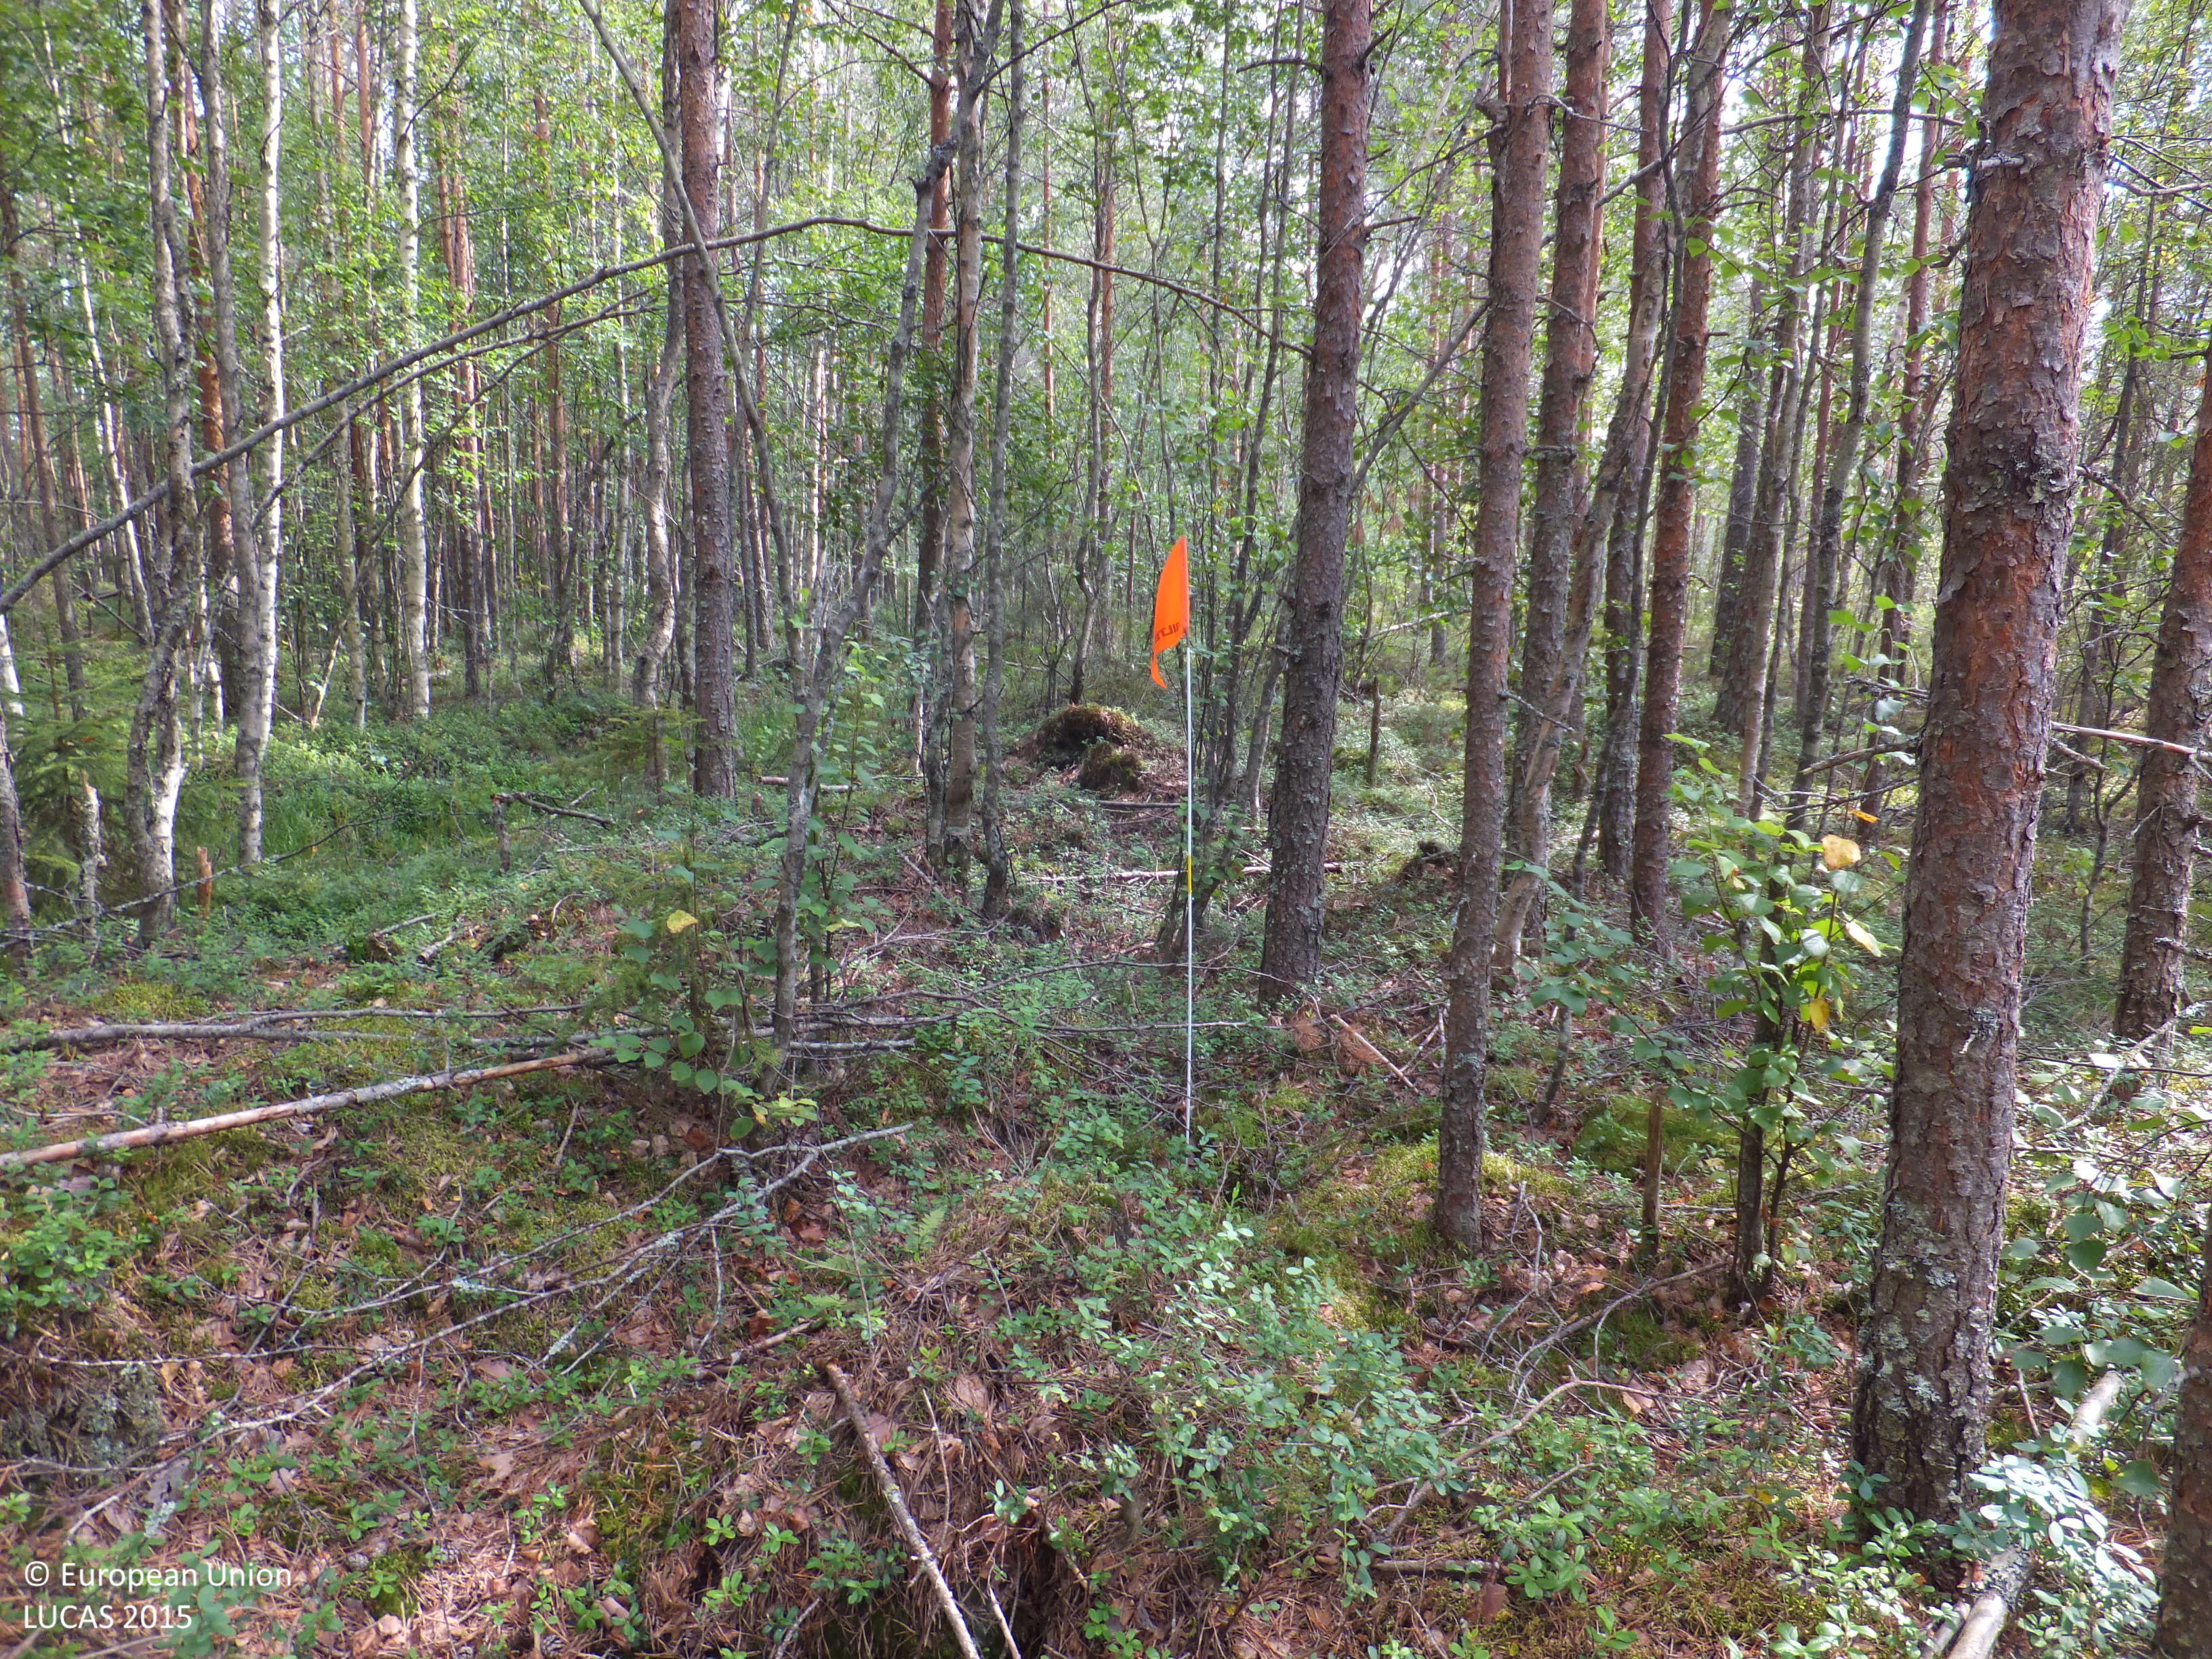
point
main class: Woodland
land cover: Pine dominated mixed woodland
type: boreal forest
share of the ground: > 75 %
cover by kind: coniferous forest trees 40 %, broadleaved forest trees 40 %, shrubs 15 %, lichens and mosses 5 %
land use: Forestry
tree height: > 5 m
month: August
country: FI
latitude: 63.1672
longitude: 22.7423
